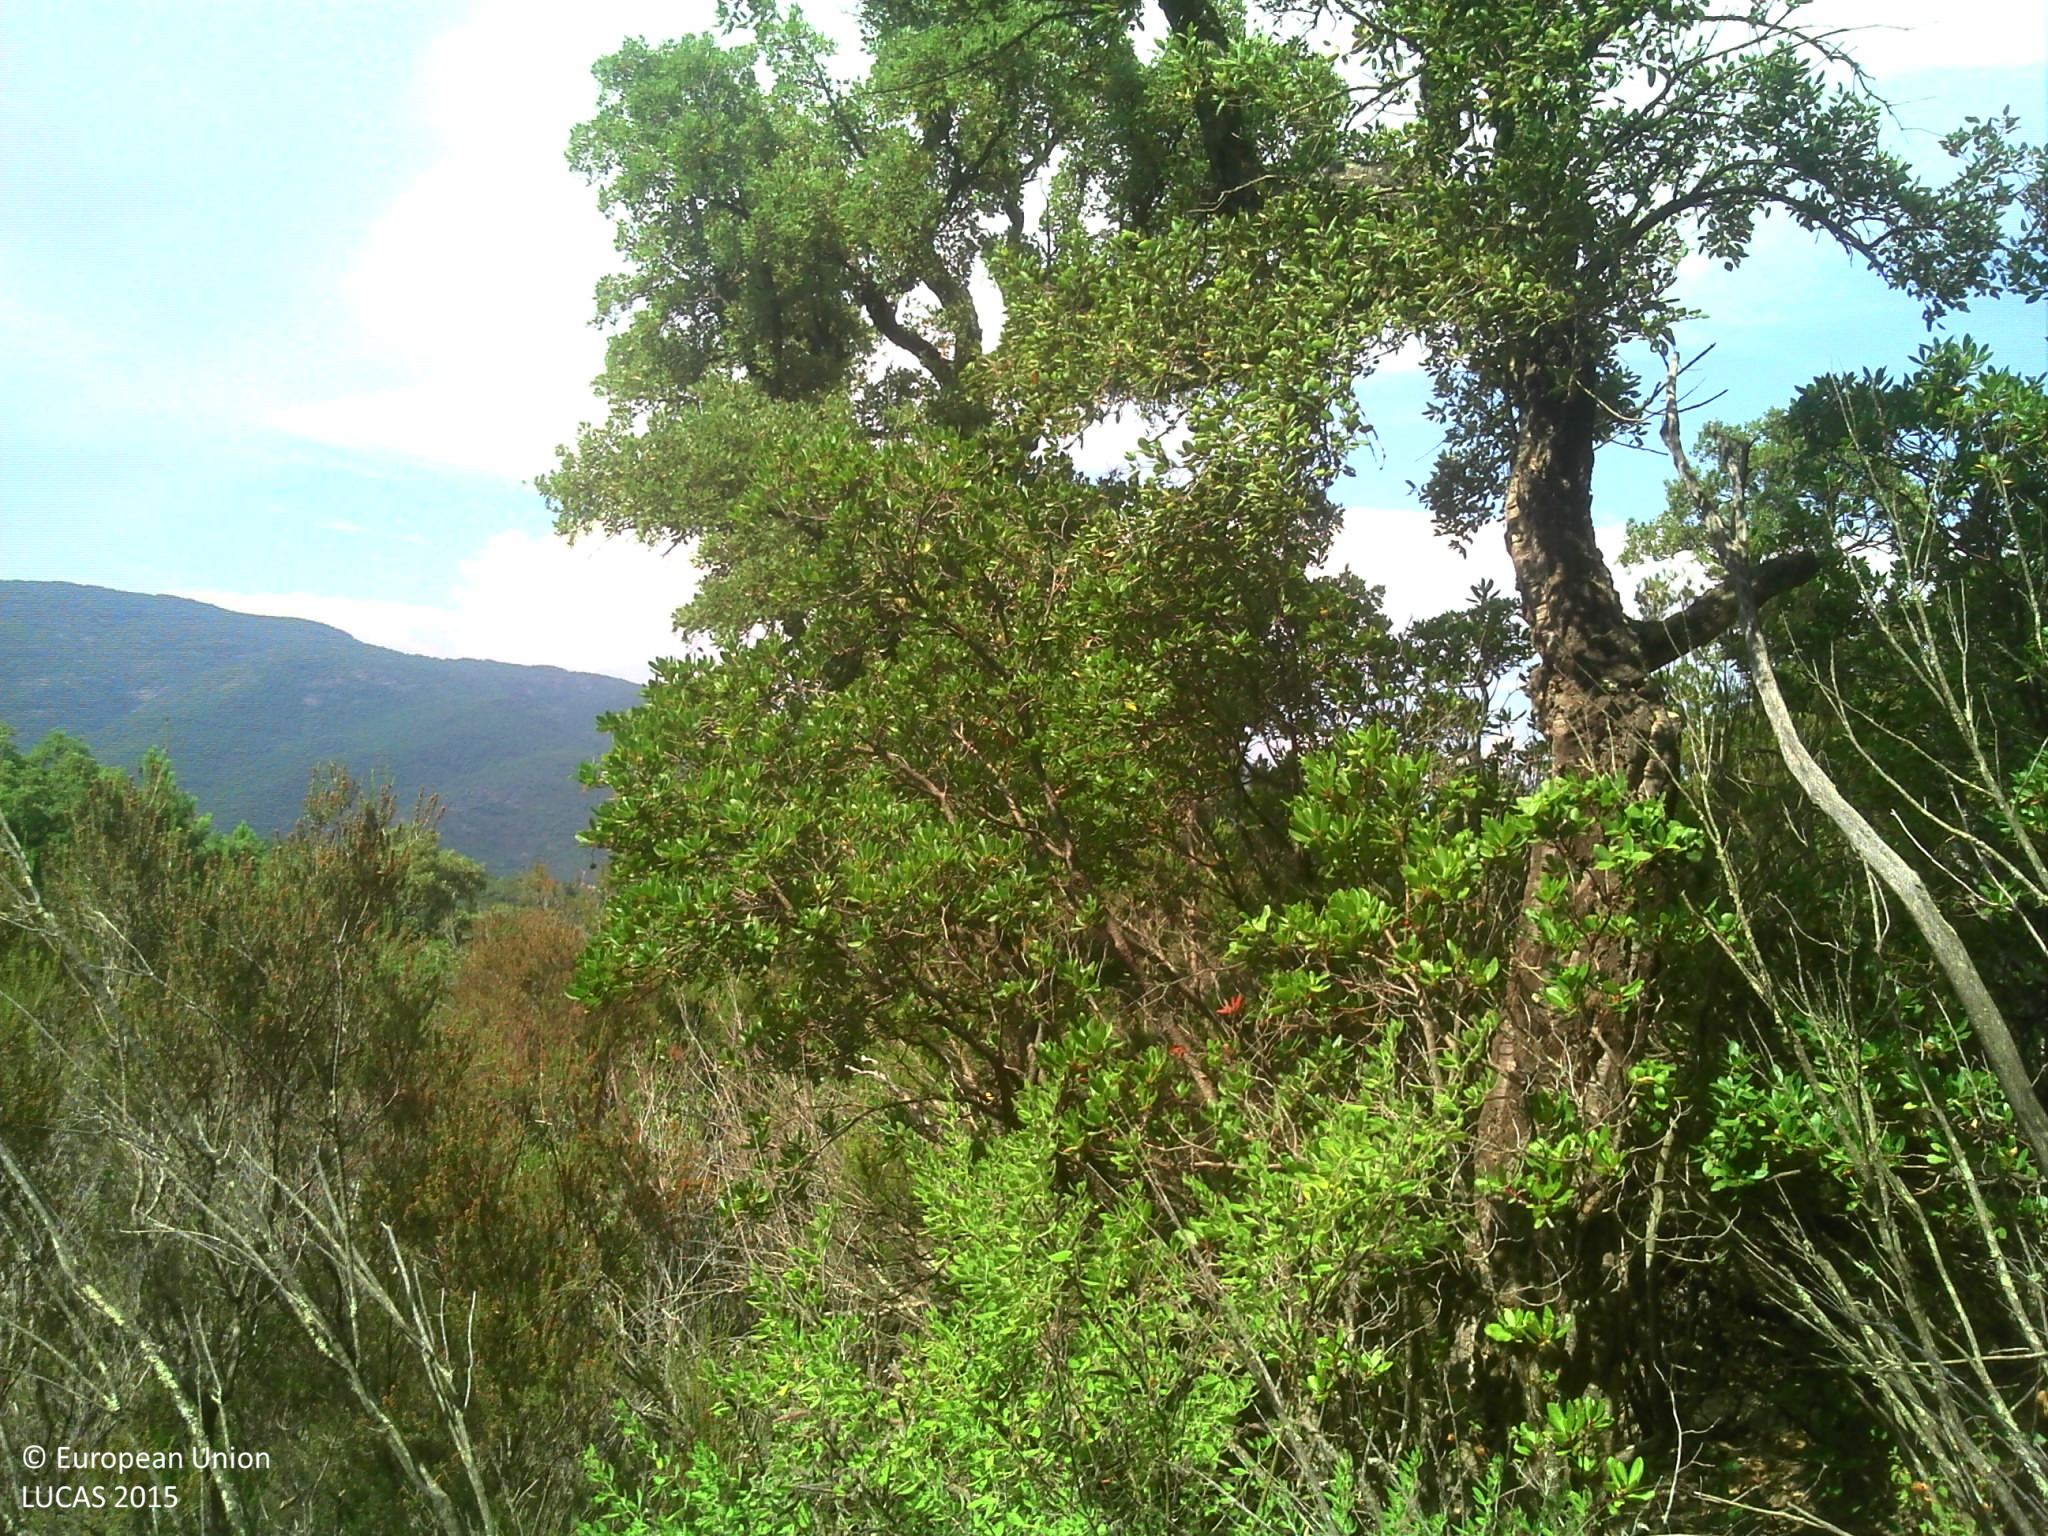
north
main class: Woodland
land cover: Pine dominated mixed woodland
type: coniferous forest of the mediterranean region
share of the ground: > 75 %
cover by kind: coniferous forest trees 50 %, broadleaved forest trees 25 %, shrubs 25 %
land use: Semi-natural and natural areas not in use
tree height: > 5 m
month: July
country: FR
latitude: 43.1866
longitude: 6.4043
